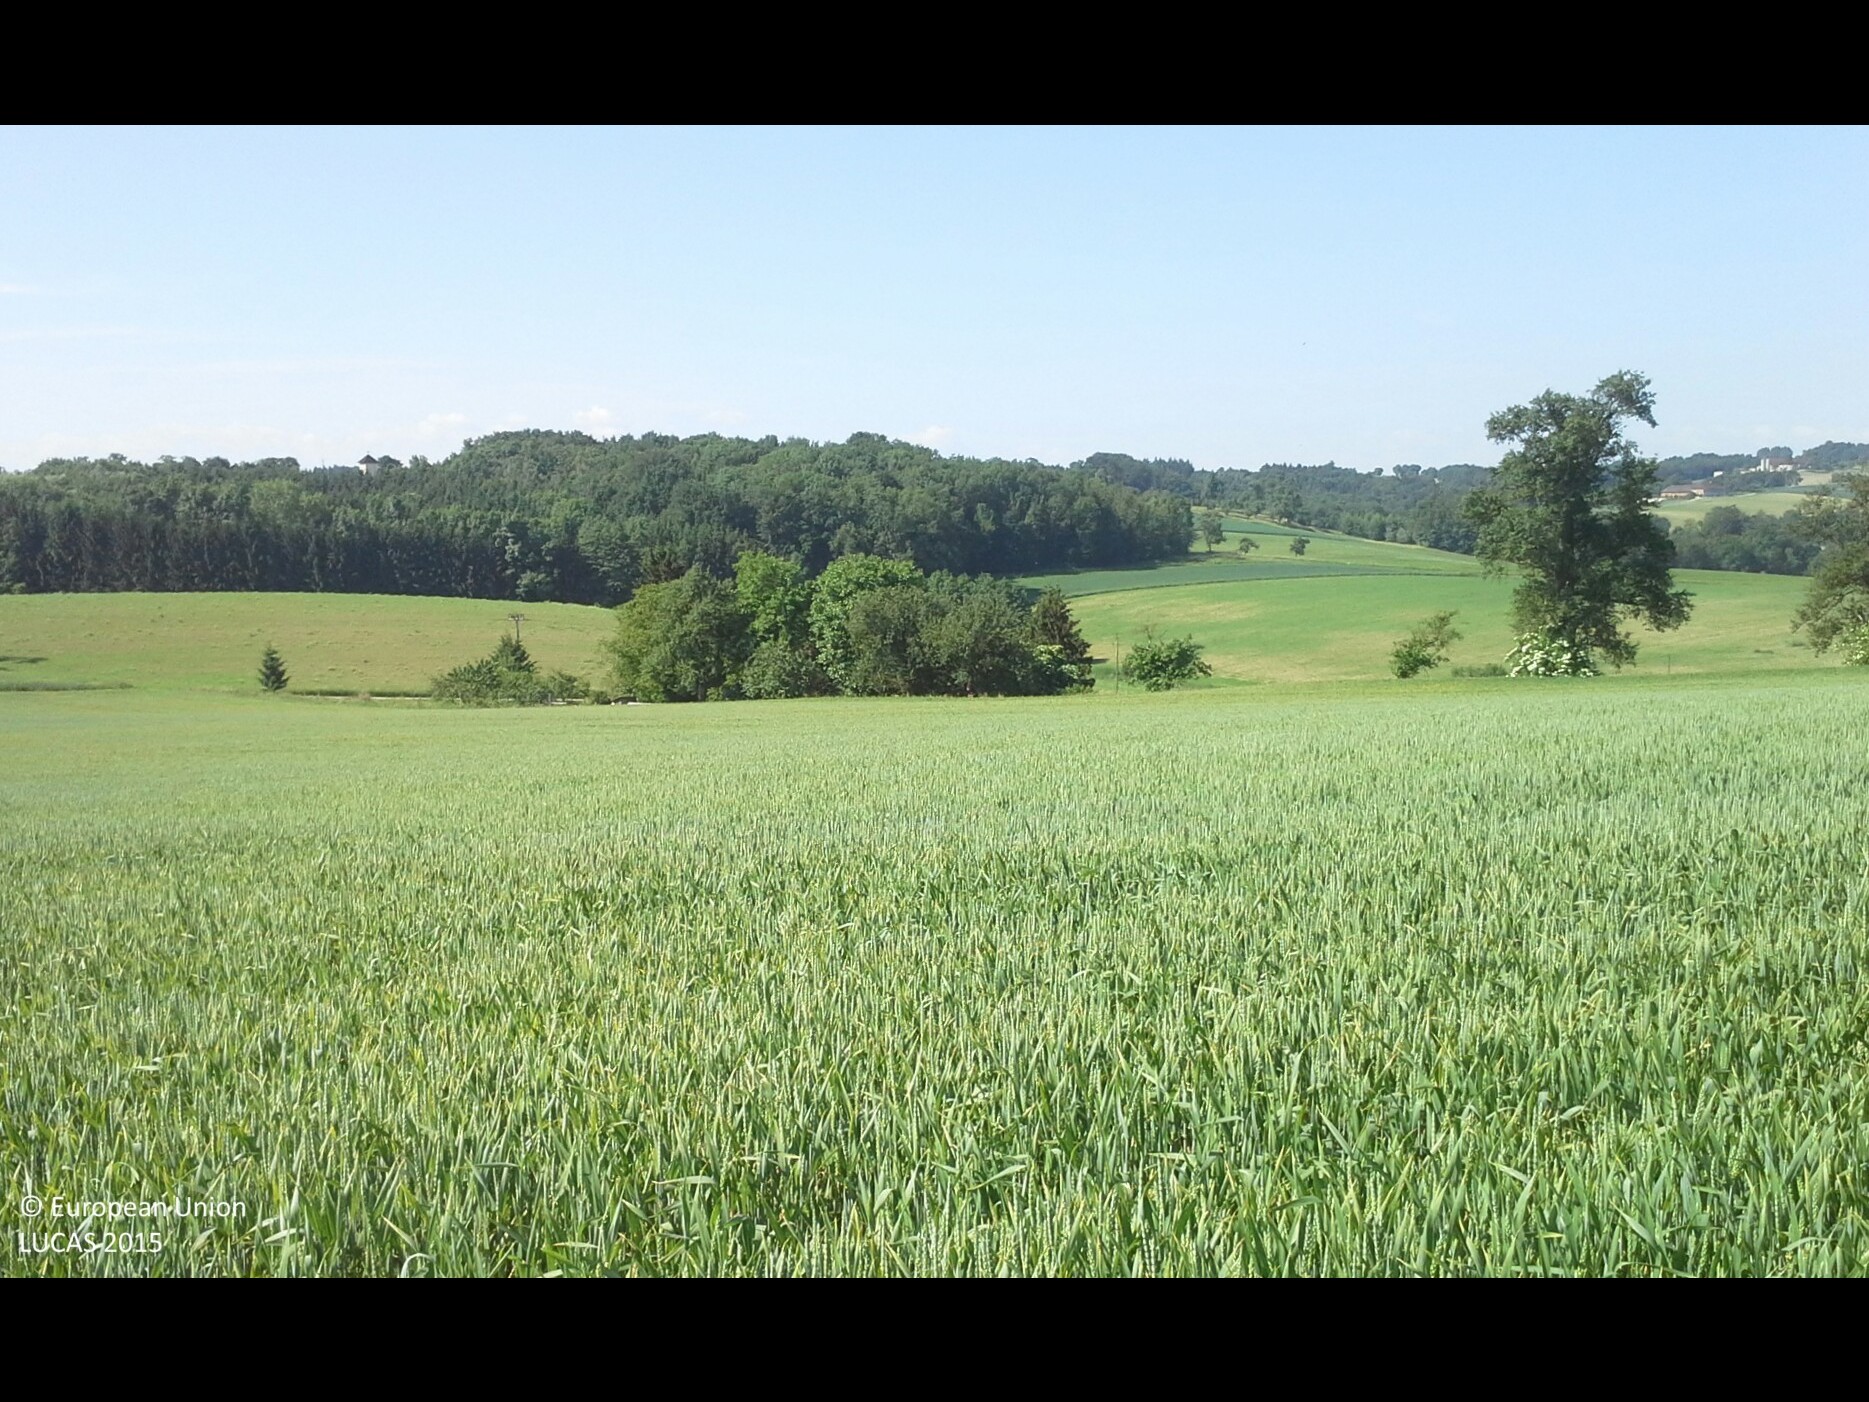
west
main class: Cropland
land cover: Common wheat
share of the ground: > 75 %
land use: Agriculture (excluding fallow land and kitchen gardens)
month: June
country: AT
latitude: 48.1642
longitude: 14.5852
